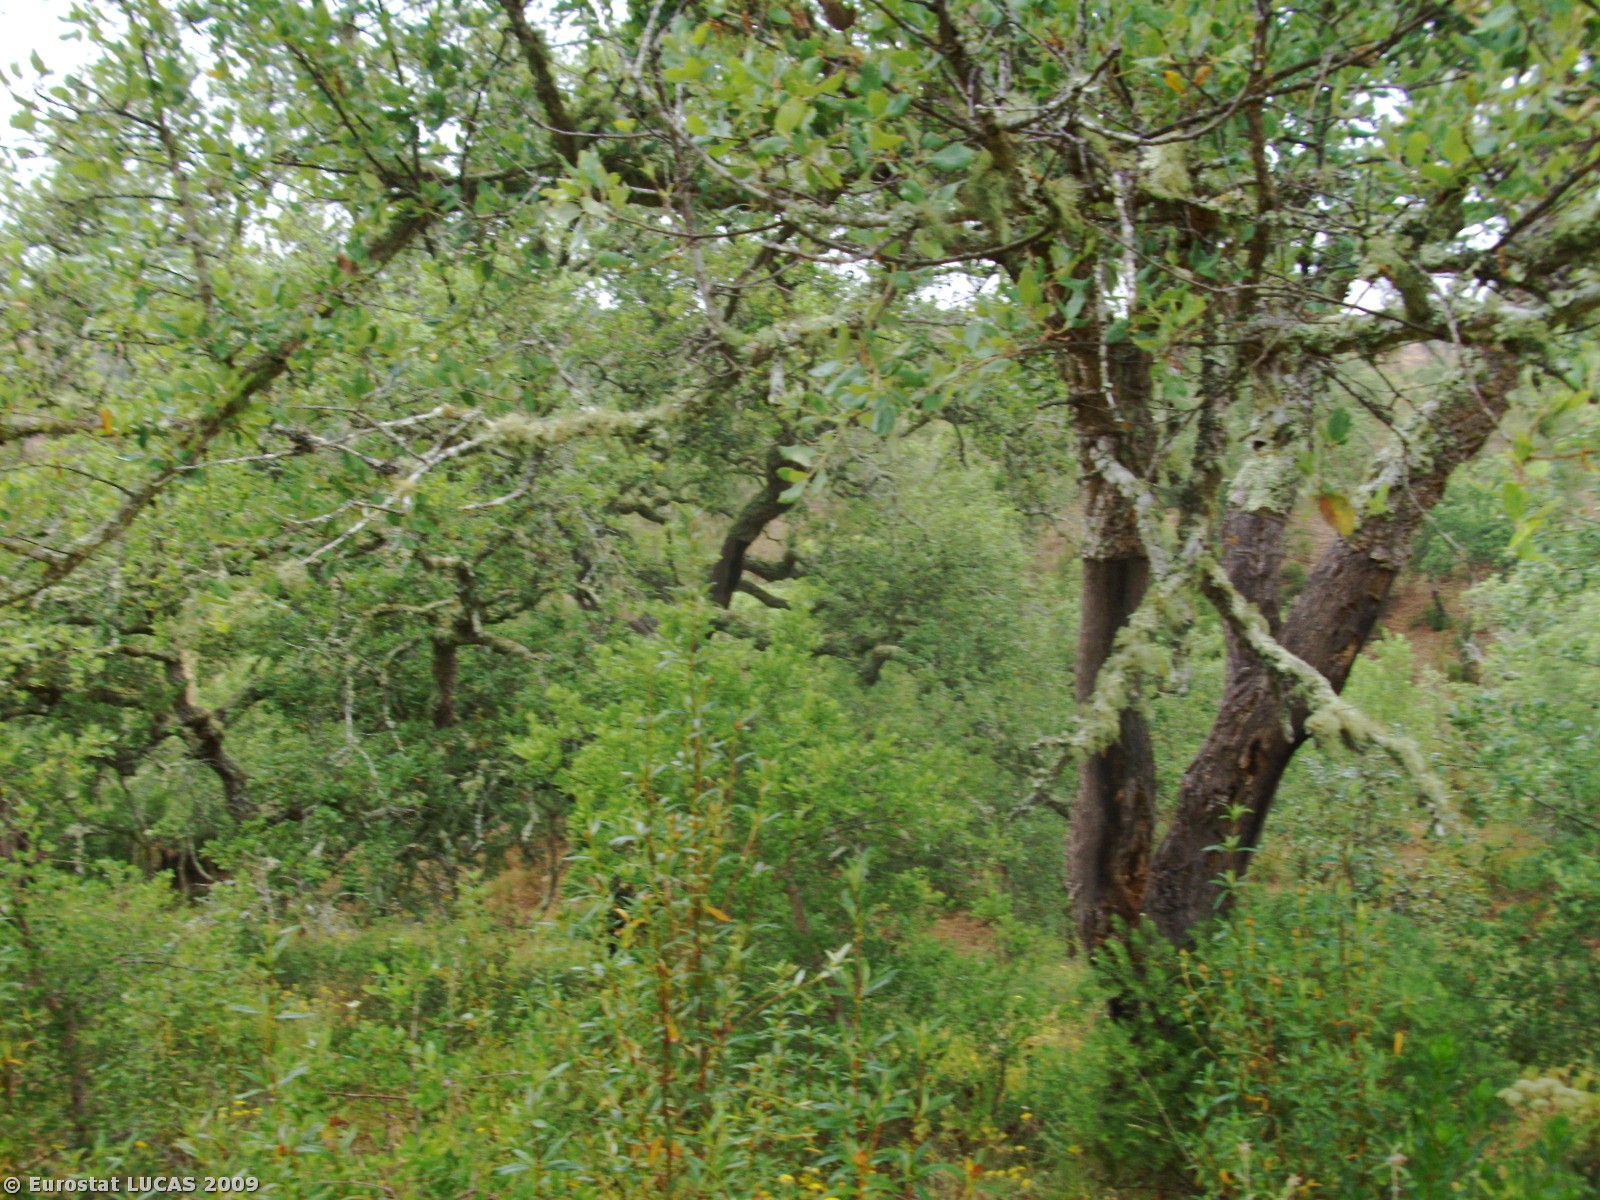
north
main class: Woodland
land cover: Broadleaved woodland
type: broadleaved evergreen forest
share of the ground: 10 - 25 %
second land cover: Spontaneously vegetated surfaces
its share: 50 - 75 %
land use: Forestry
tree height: > 5 m
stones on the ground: 10 - 25 %
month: June
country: PT
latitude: 37.5342
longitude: -8.4672
